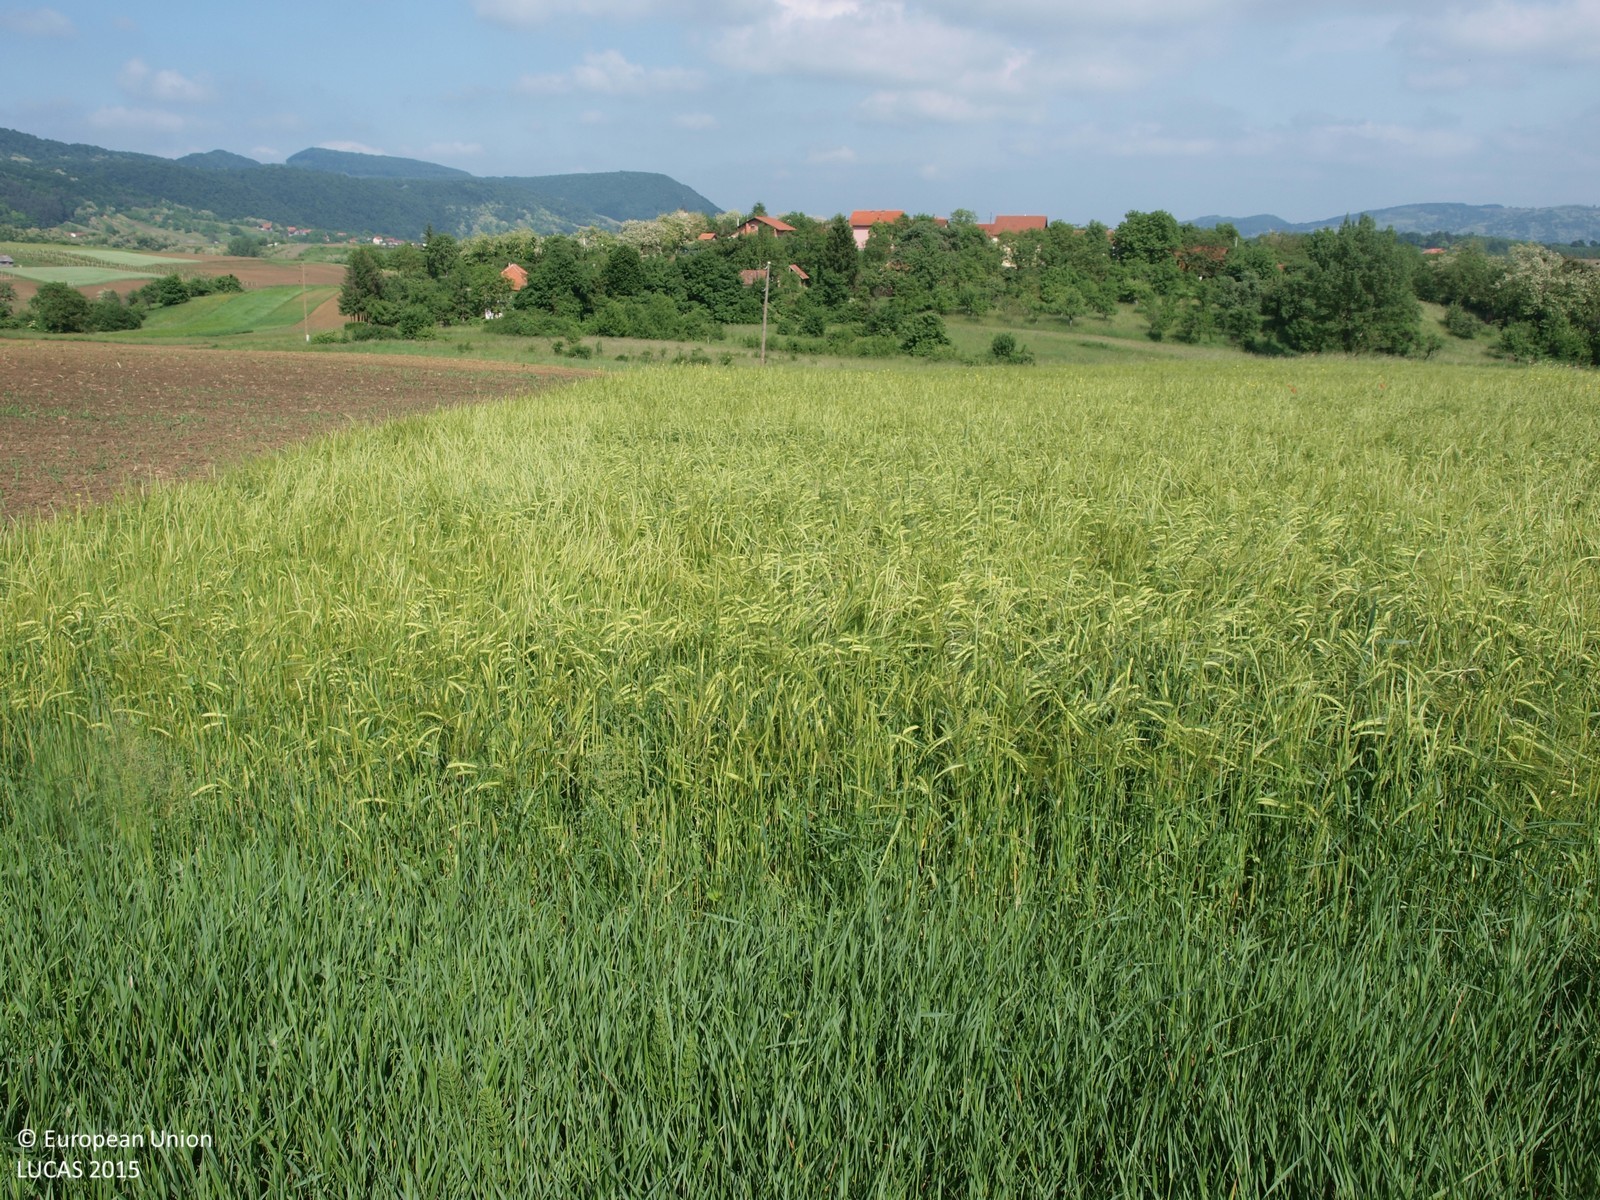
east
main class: Grassland
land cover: Grassland without tree/shrub cover
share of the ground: > 75 %
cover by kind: herbaceous plants 100 %
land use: Agriculture (excluding fallow land and kitchen gardens)
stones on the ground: < 10 %
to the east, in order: Grassland without tree/shrub cover; Barley; Electric lines; Barley; Grassland without tree/shrub cover; Grassland with sparse tree/shrub cover; Managed hedges; Artificial constructions in urban areas
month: May
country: HR
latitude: 46.1547
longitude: 16.1757
